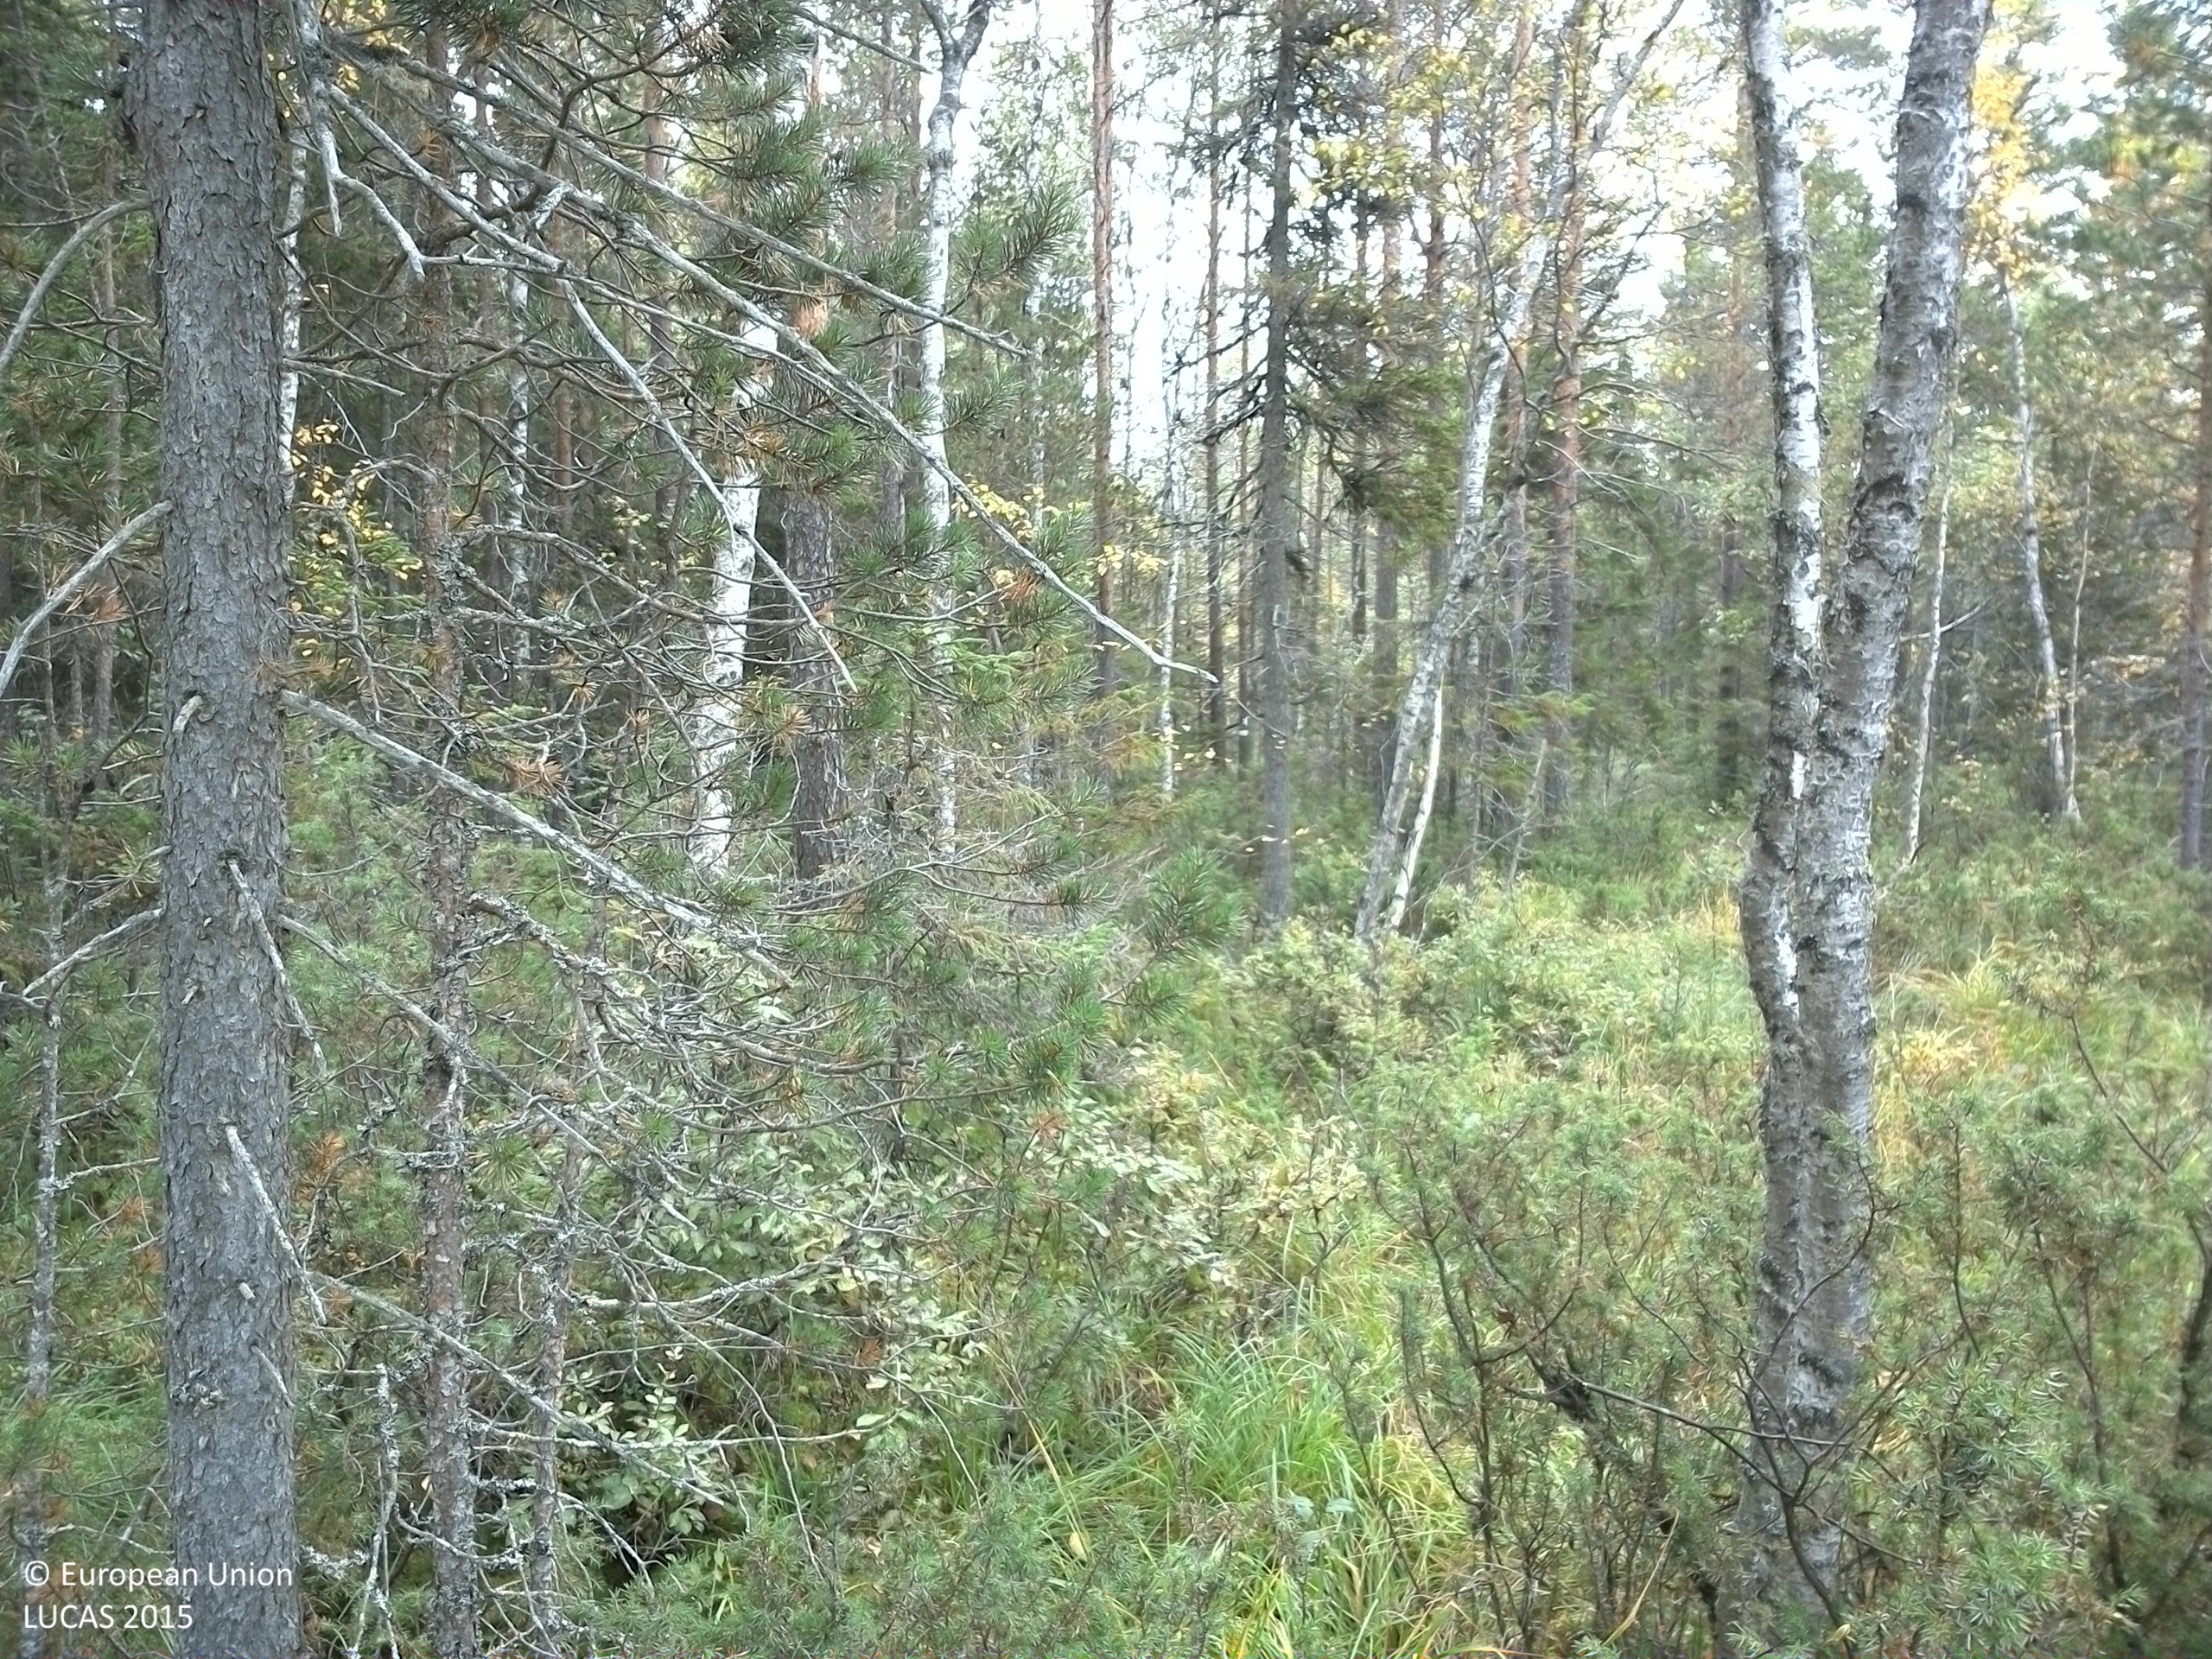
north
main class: Woodland
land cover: Pine dominated mixed woodland
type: boreal forest
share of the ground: 50 - 75 %
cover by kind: coniferous forest trees 45 %, broadleaved forest trees 20 %, lichens and mosses 20 %, shrubs 15 %
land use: Forestry
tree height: > 5 m
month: September
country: SE
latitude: 61.5485
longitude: 15.1584
